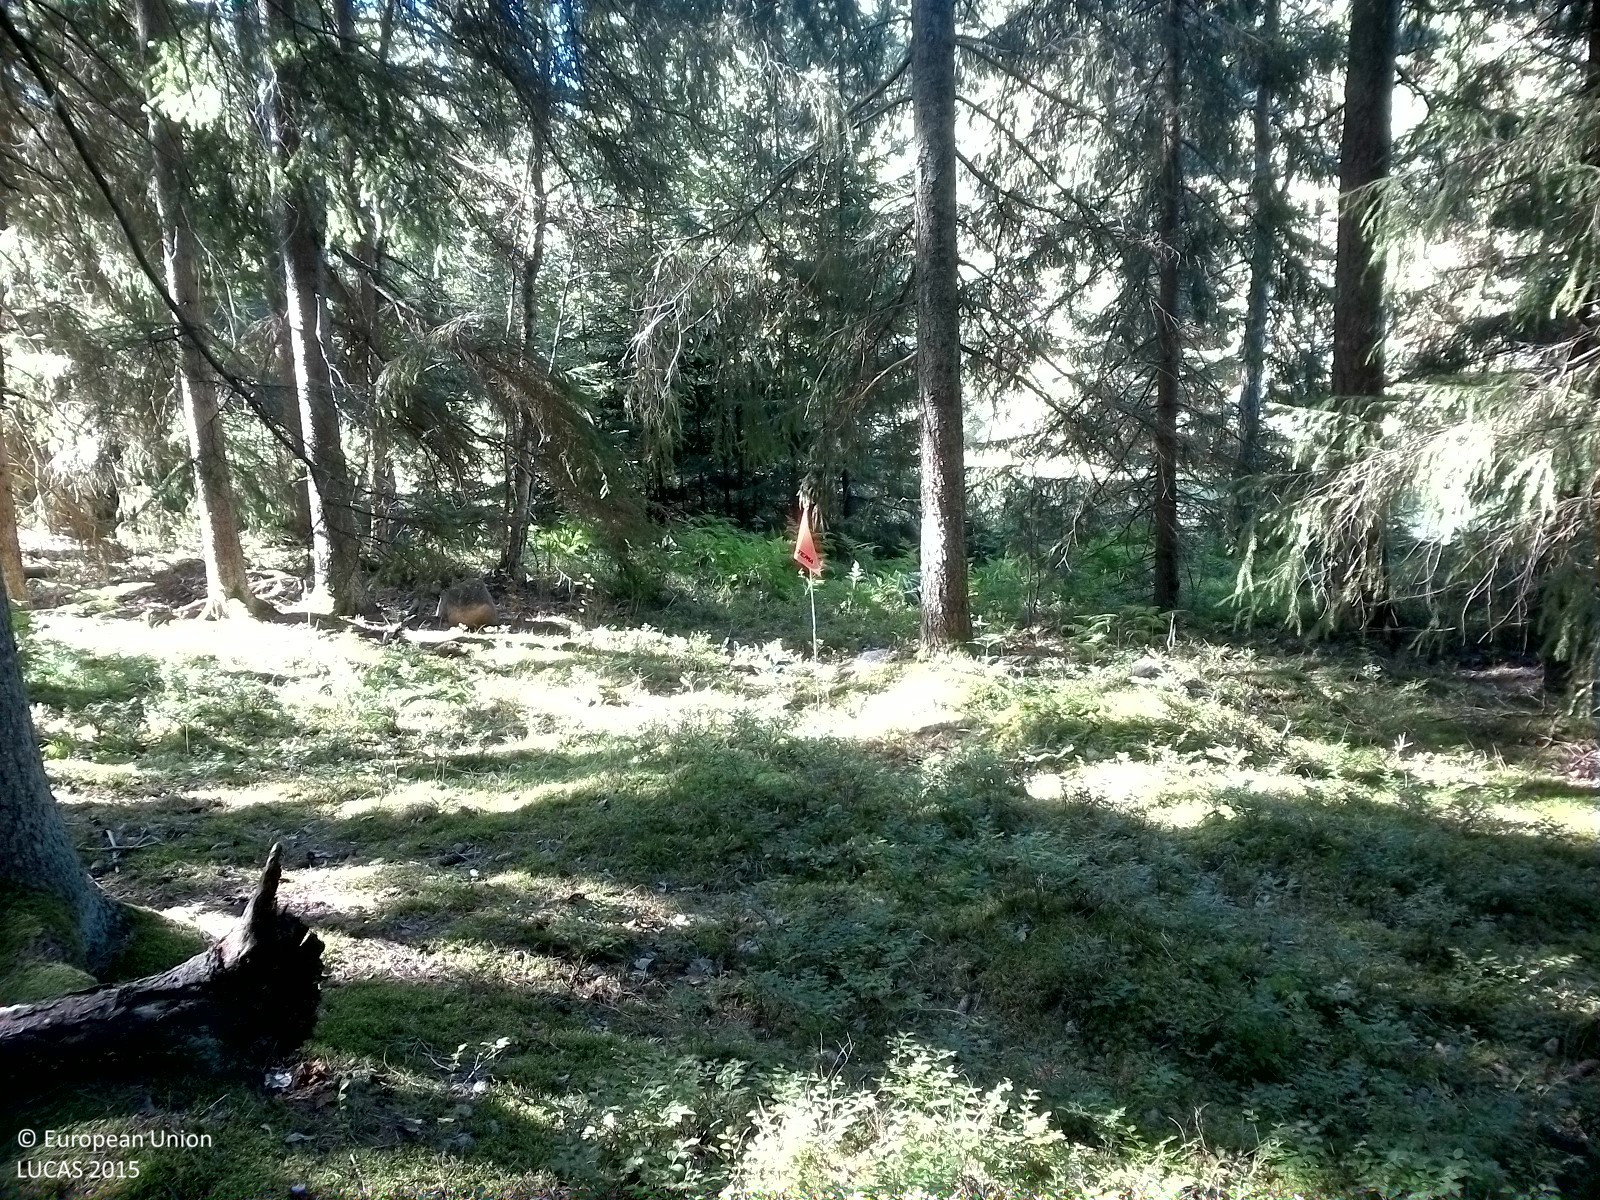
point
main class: Woodland
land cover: Spruce dominated coniferous woodland
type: boreal forest
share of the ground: 50 - 75 %
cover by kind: coniferous forest trees 55 %, lichens and mosses 30 %, herbaceous plants 15 %
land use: Forestry
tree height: > 5 m
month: August
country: SE
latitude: 59.4011
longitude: 15.1518
